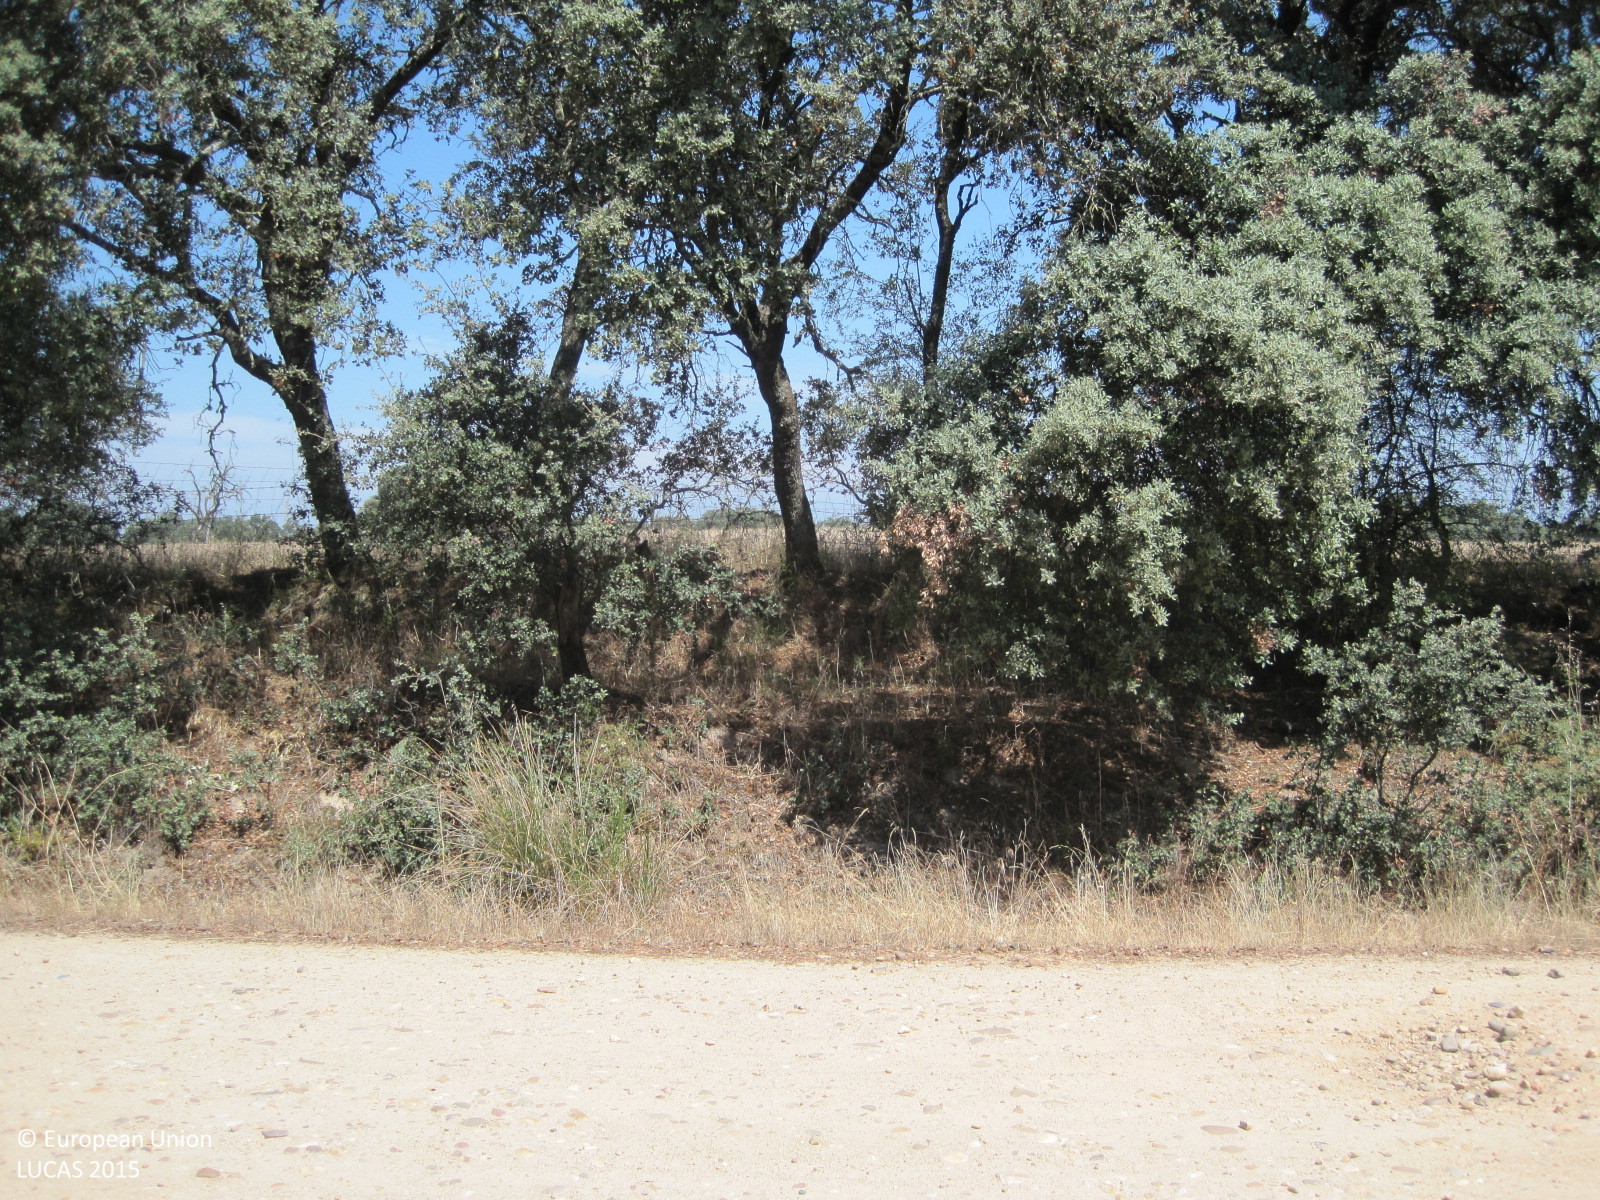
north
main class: Woodland
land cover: Broadleaved woodland
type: broadleaved evergreen forest
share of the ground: 50 - 75 %
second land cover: Shrubland without tree cover
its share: 50 - 75 %
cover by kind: broadleaved forest trees 65 %, shrubs 25 %, herbaceous plants 10 %
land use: Forestry
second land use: Agriculture (excluding fallow land and kitchen gardens)
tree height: > 5 m
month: July
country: ES
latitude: 39.9518
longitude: -5.1168
